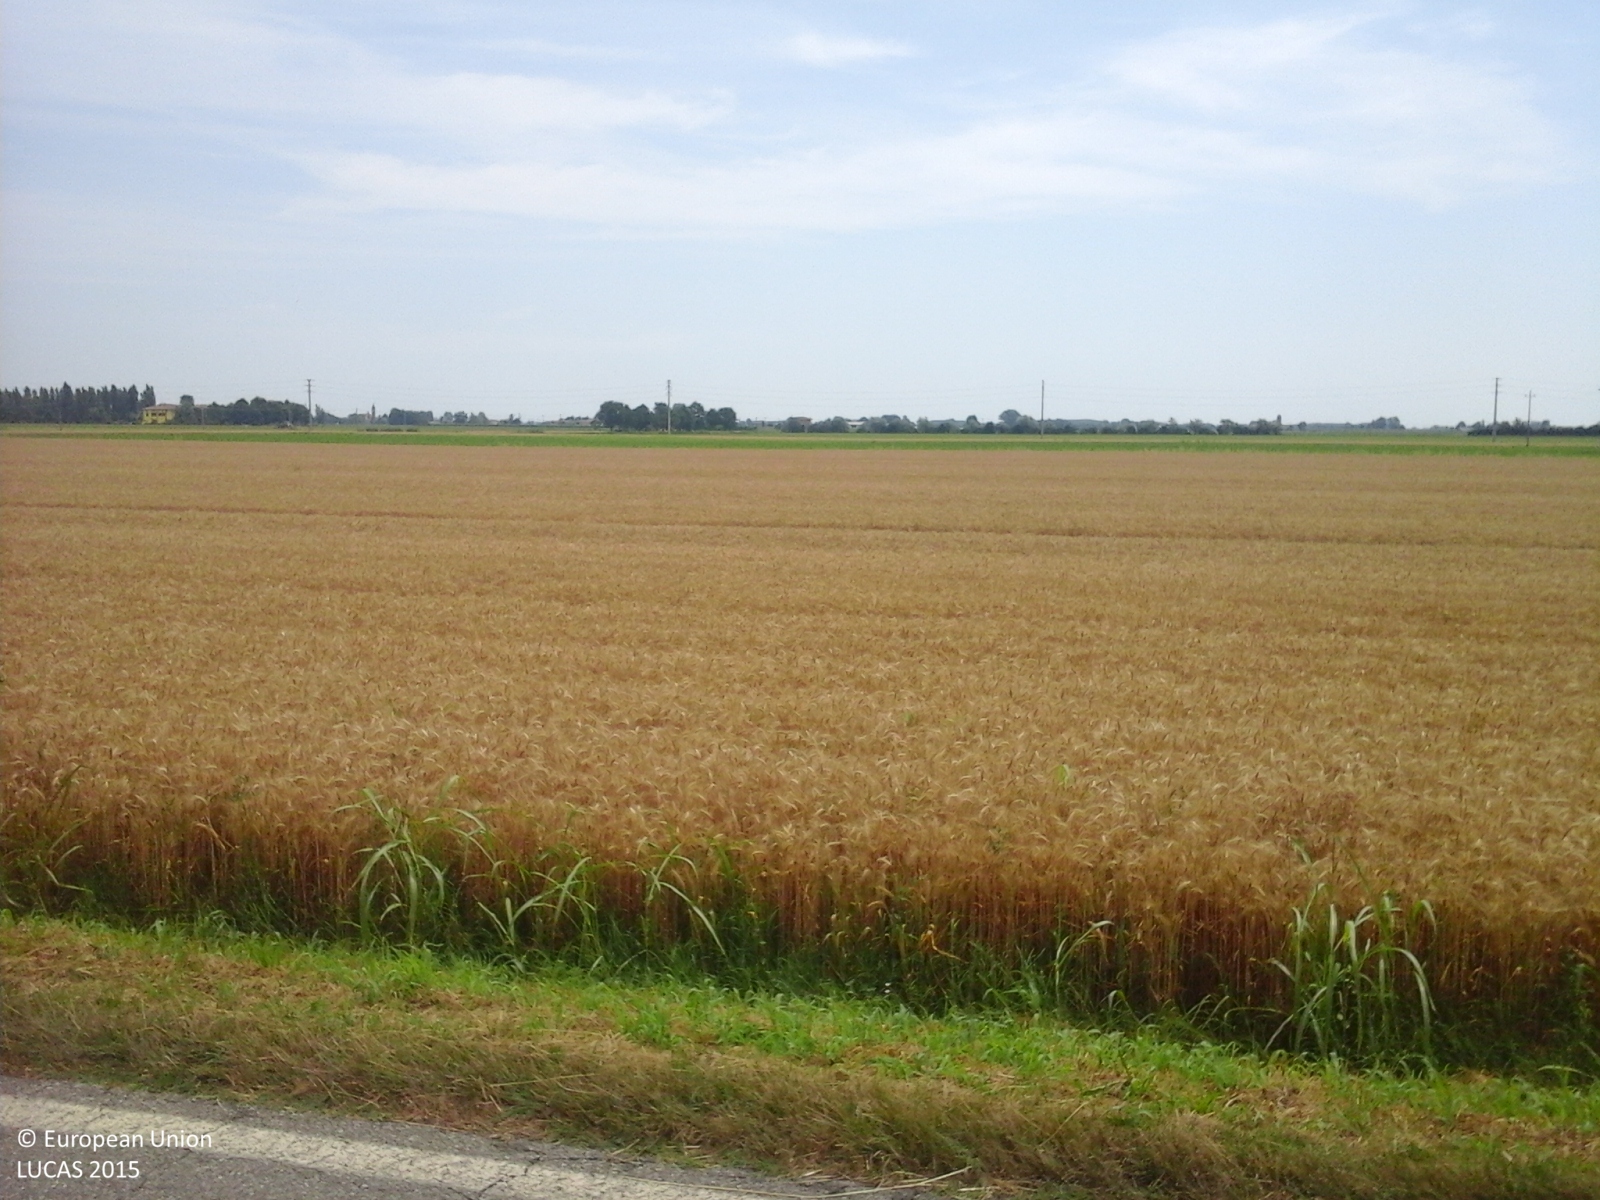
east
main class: Cropland
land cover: Common wheat
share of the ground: > 75 %
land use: Agriculture (excluding fallow land and kitchen gardens)
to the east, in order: Common wheat; Grass margins; Inland fresh running water; Grass margins; Paved roads, cycling and walking lanes; Grass margins; Electric lines; Common wheat; Ditches and canals; Common wheat; Ditches and canals; Common wheat; Ditches and canals; Common wheat; Ditches and canals; Common wheat; Ditches and canals; Sugar beet; Ditches and canals; Sugar beet
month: June
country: IT
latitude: 44.6336
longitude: 11.0692
